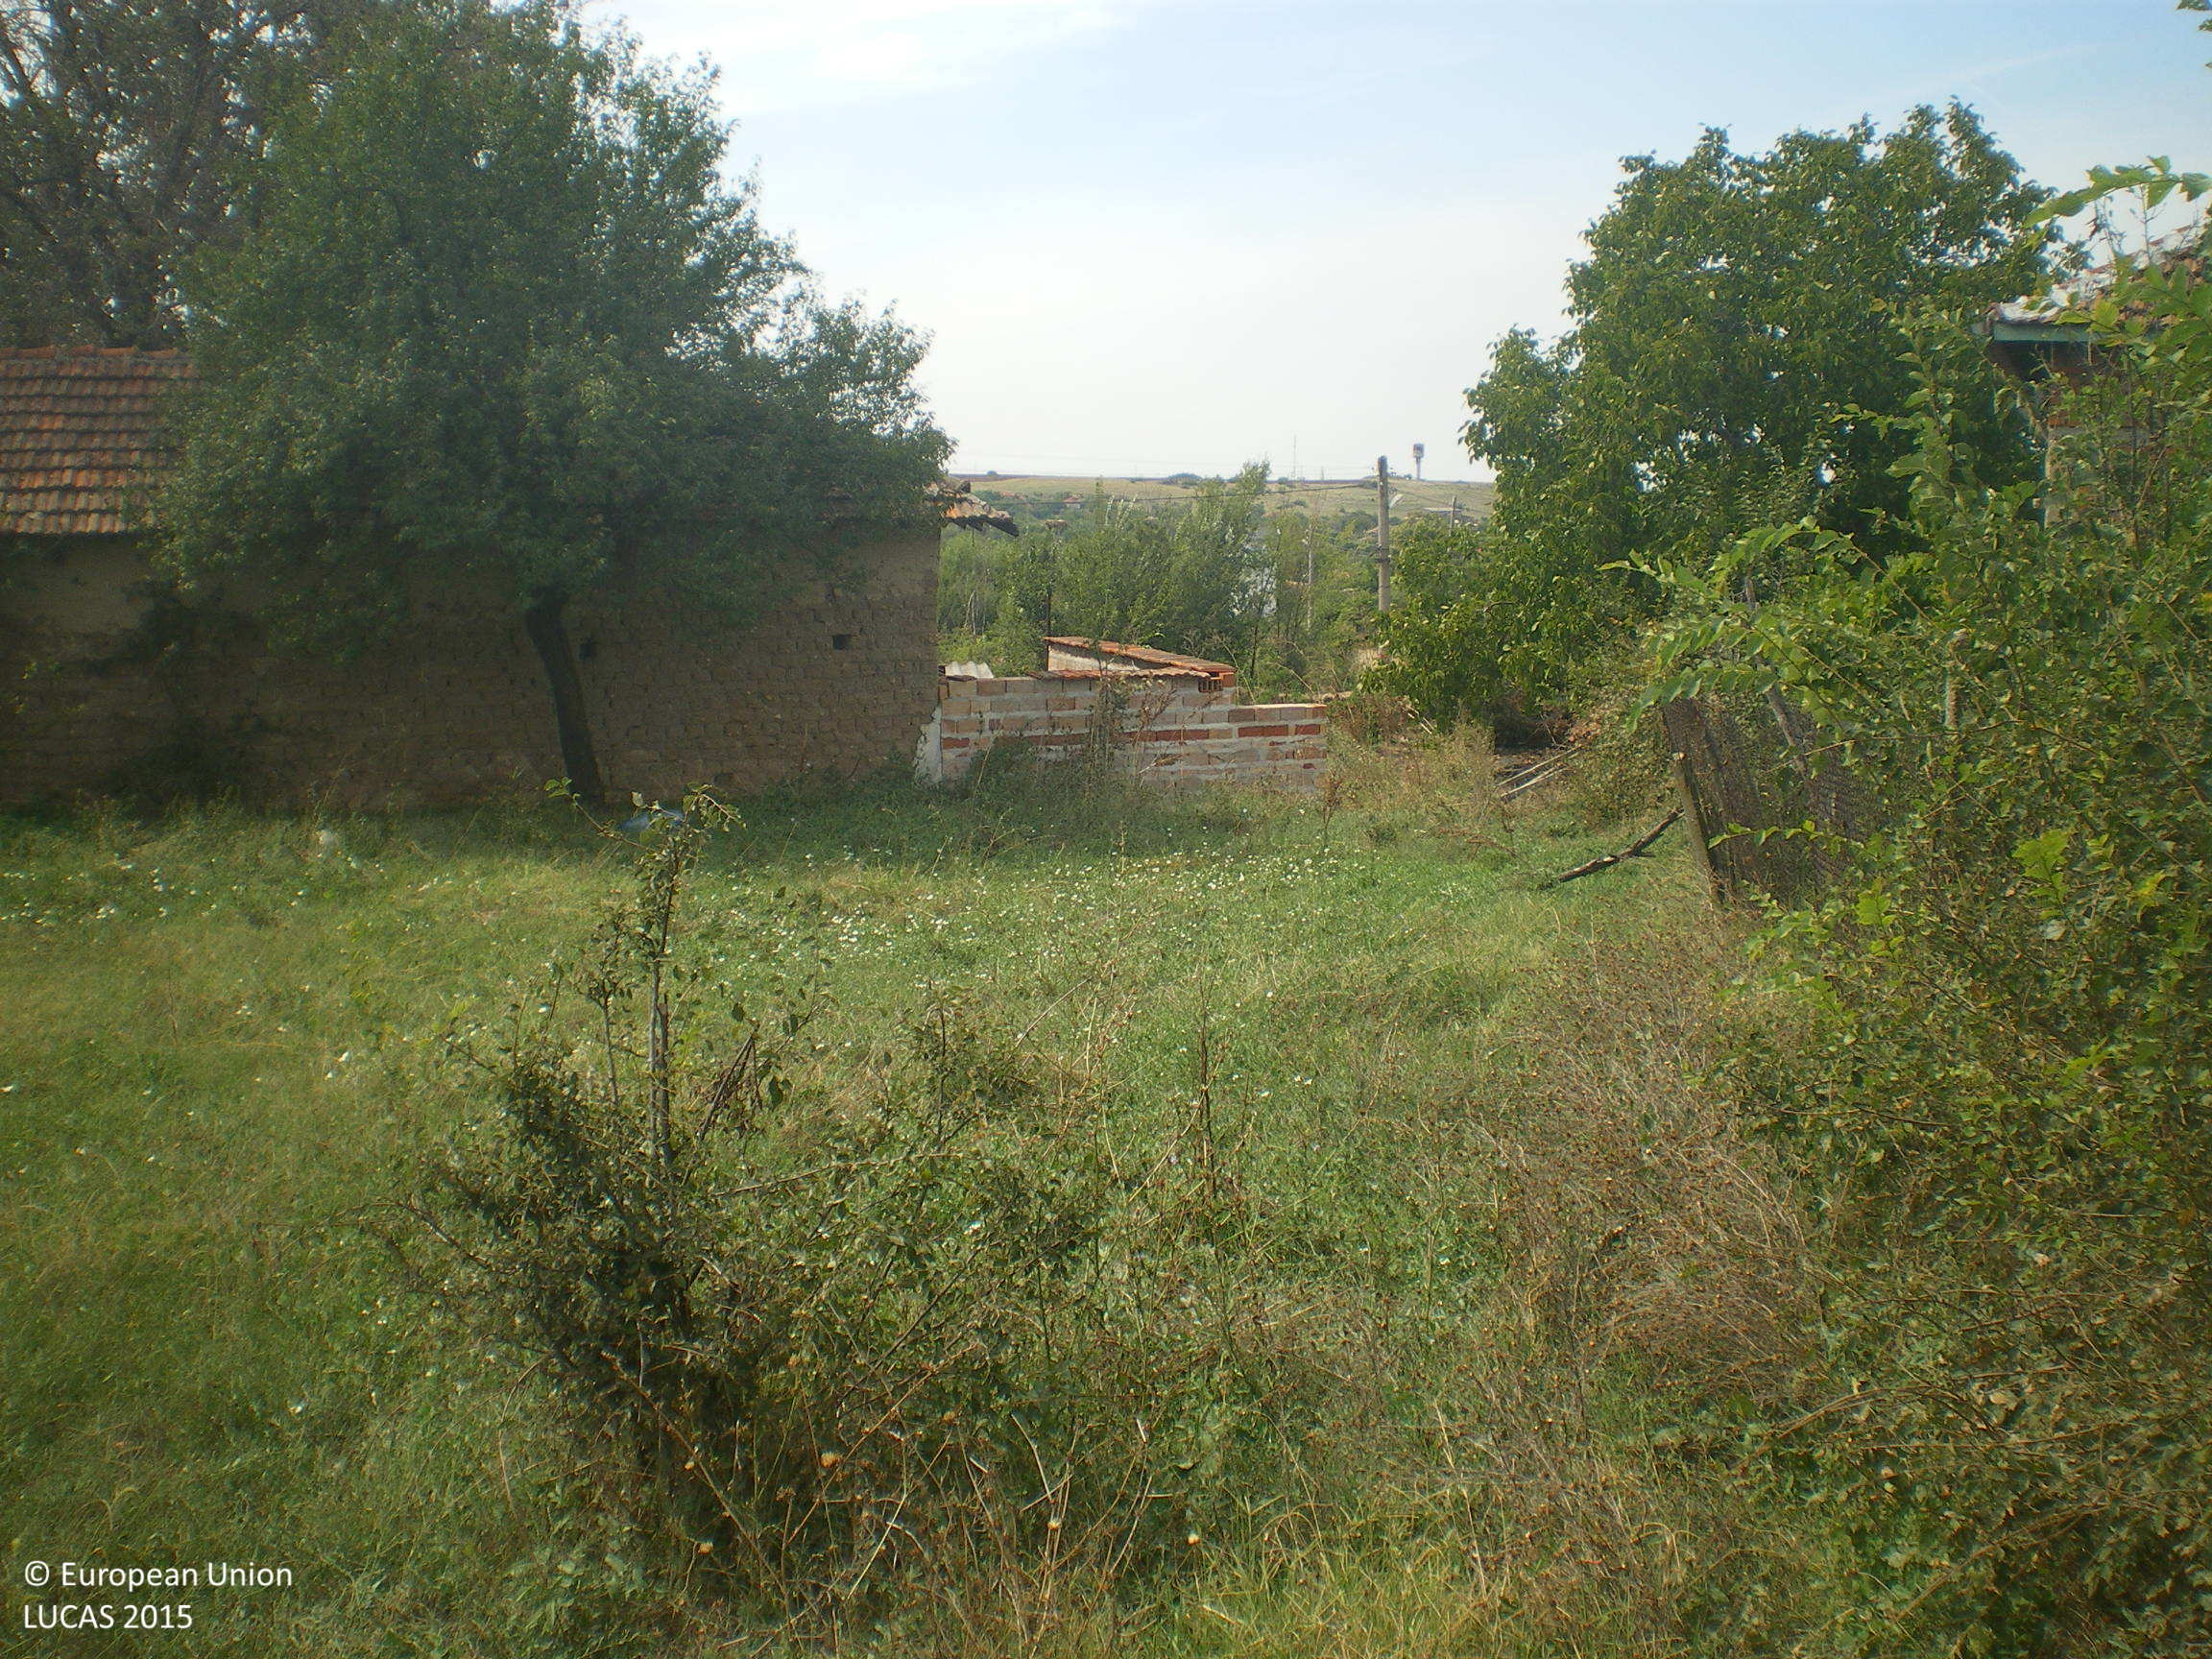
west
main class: Cropland
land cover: Other fresh vegetables
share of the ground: 50 - 75 %
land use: Kitchen garden
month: September
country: BG
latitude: 42.1247
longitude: 26.0072
